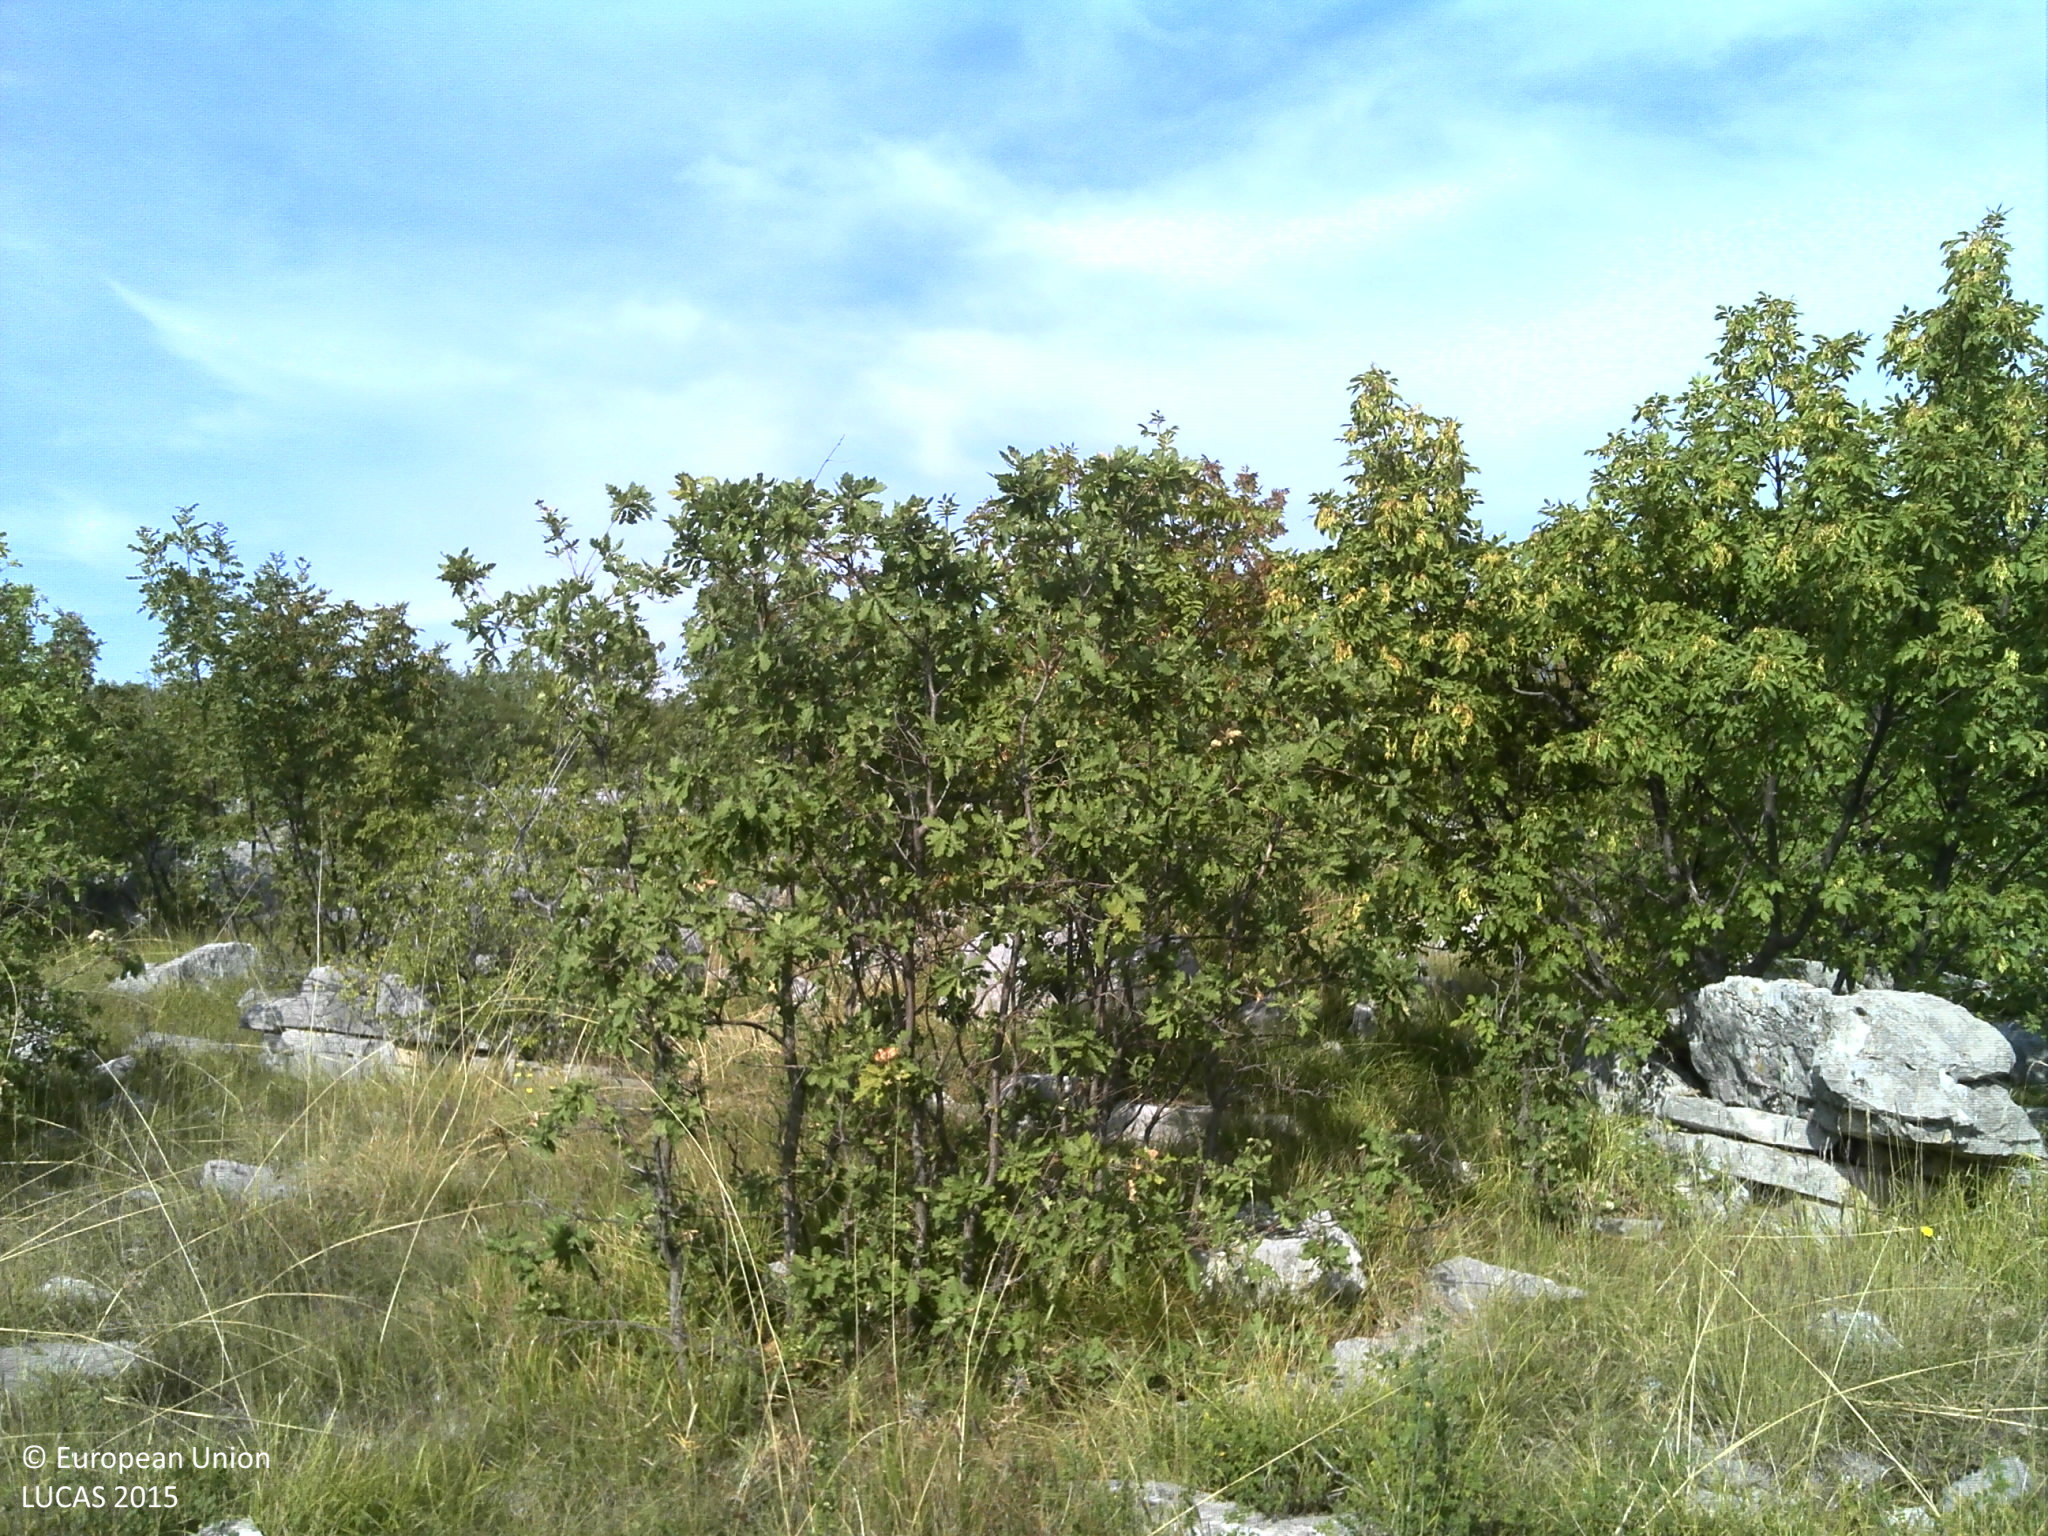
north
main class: Shrubland
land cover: Shrubland with sparse tree cover
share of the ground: 25 - 50 %
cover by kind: herbaceous plants 40 %, shrubs 25 %, consolidated bare surface 20 %, unconsolidated bare surface 10 %, broadleaved forest trees 5 %
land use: Semi-natural and natural areas not in use
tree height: < 5 m
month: September
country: HR
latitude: 43.8516
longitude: 16.2990
